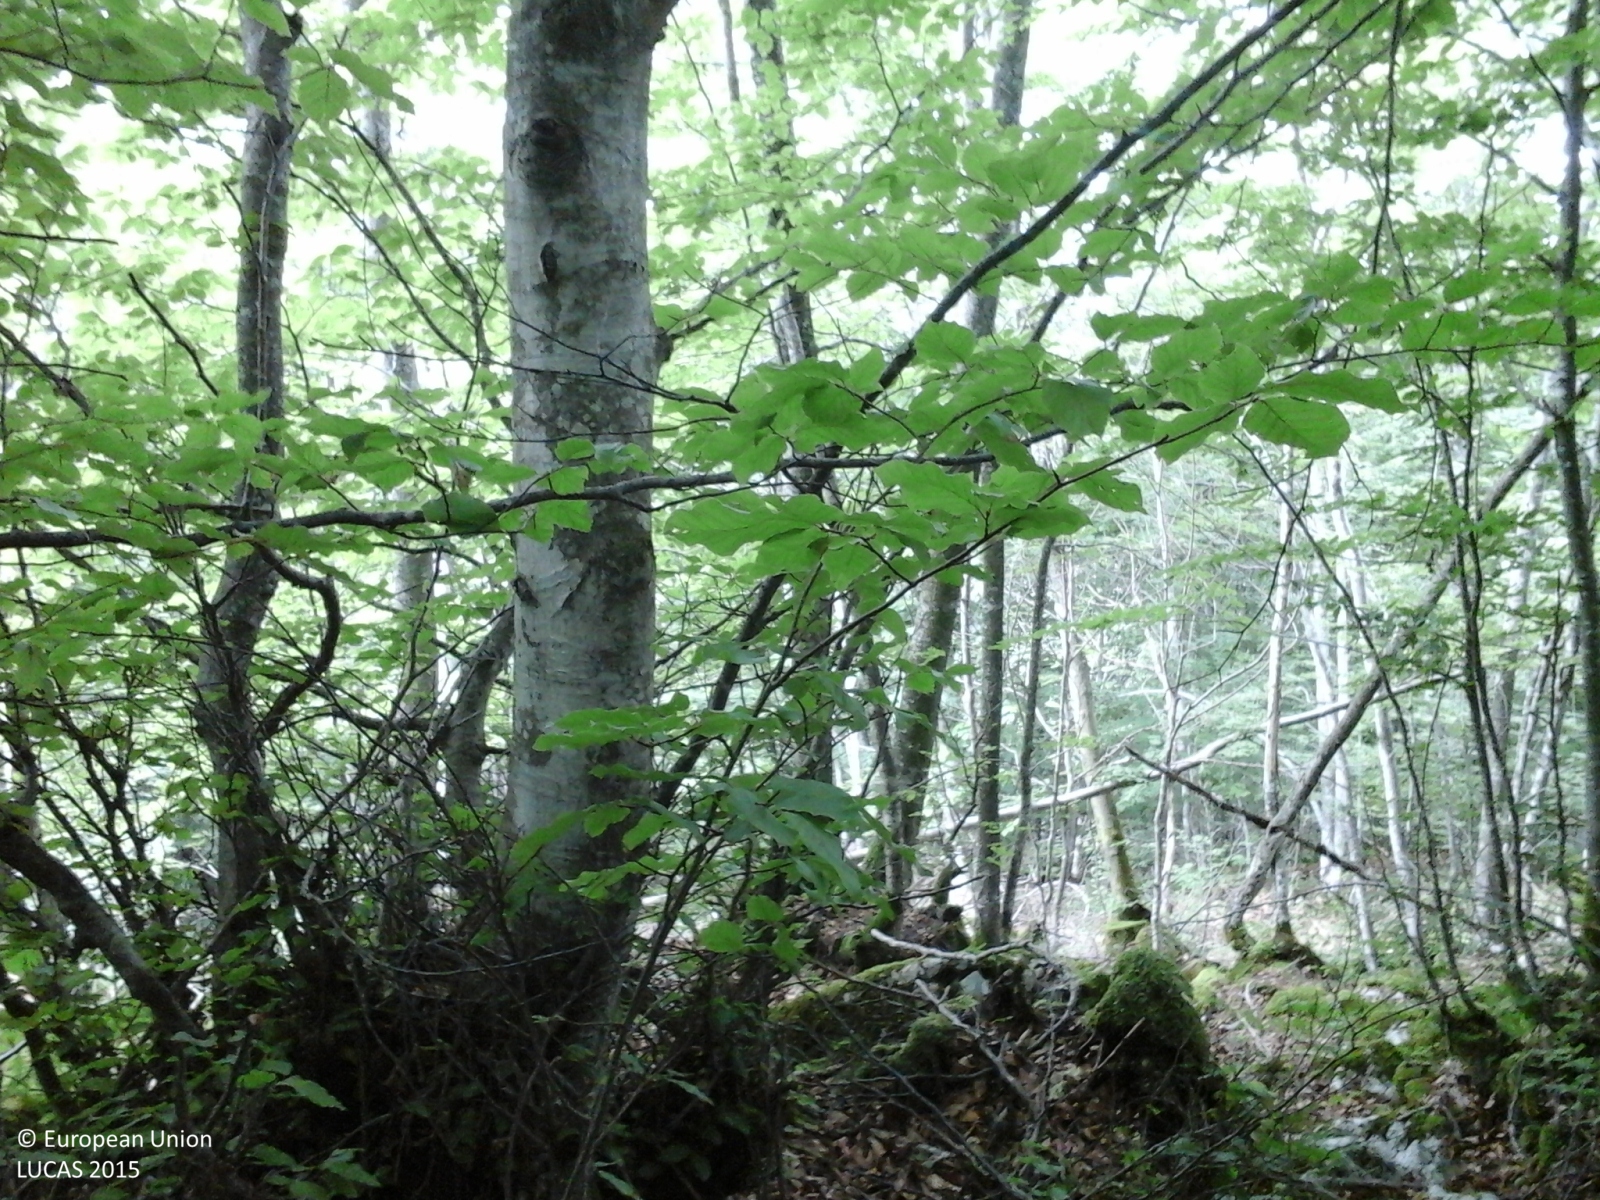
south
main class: Woodland
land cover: Broadleaved woodland
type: mountainous beech forest
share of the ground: > 75 %
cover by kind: broadleaved forest trees 100 %
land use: Forestry
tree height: > 5 m
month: June
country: IT
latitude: 45.8522
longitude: 11.6331
